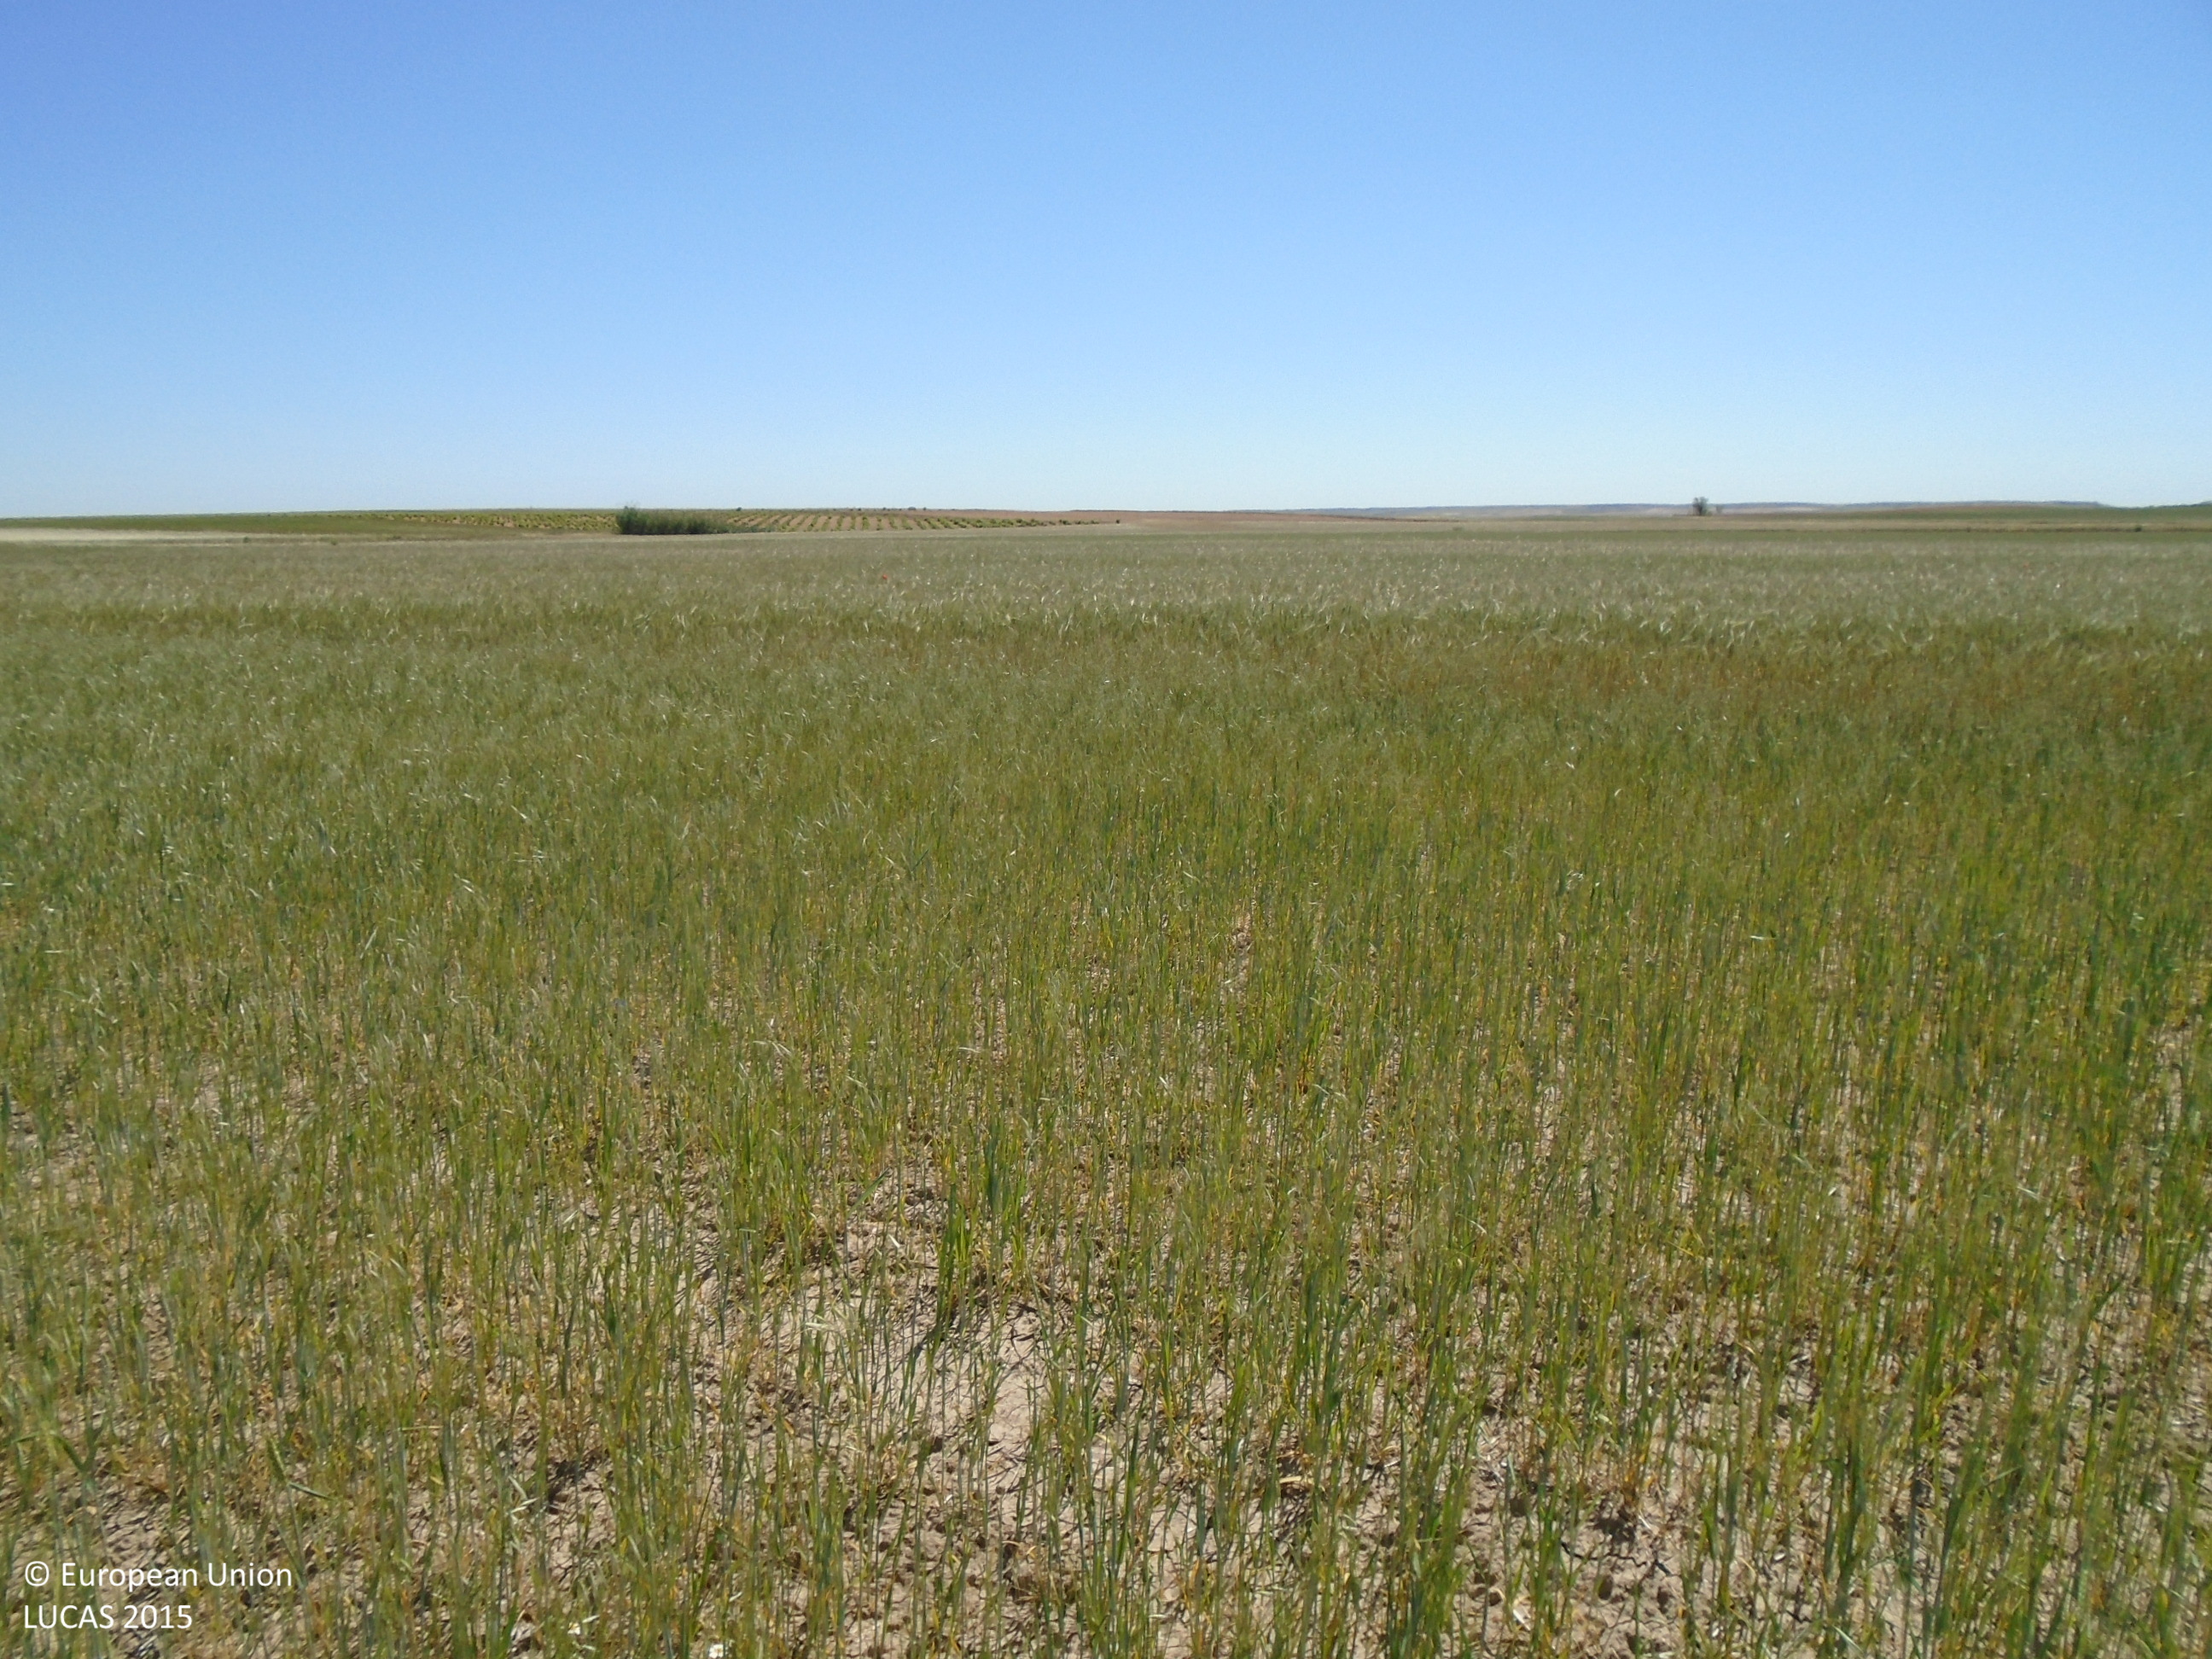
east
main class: Cropland
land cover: Common wheat
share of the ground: > 75 %
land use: Agriculture (excluding fallow land and kitchen gardens)
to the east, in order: Common wheat; Grass margins; Barley; Grass margins; Tracks; Grass margins; Oats; Grass margins; Barley; Grass margins; Barley
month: May
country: ES
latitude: 39.7484
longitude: -3.6475
